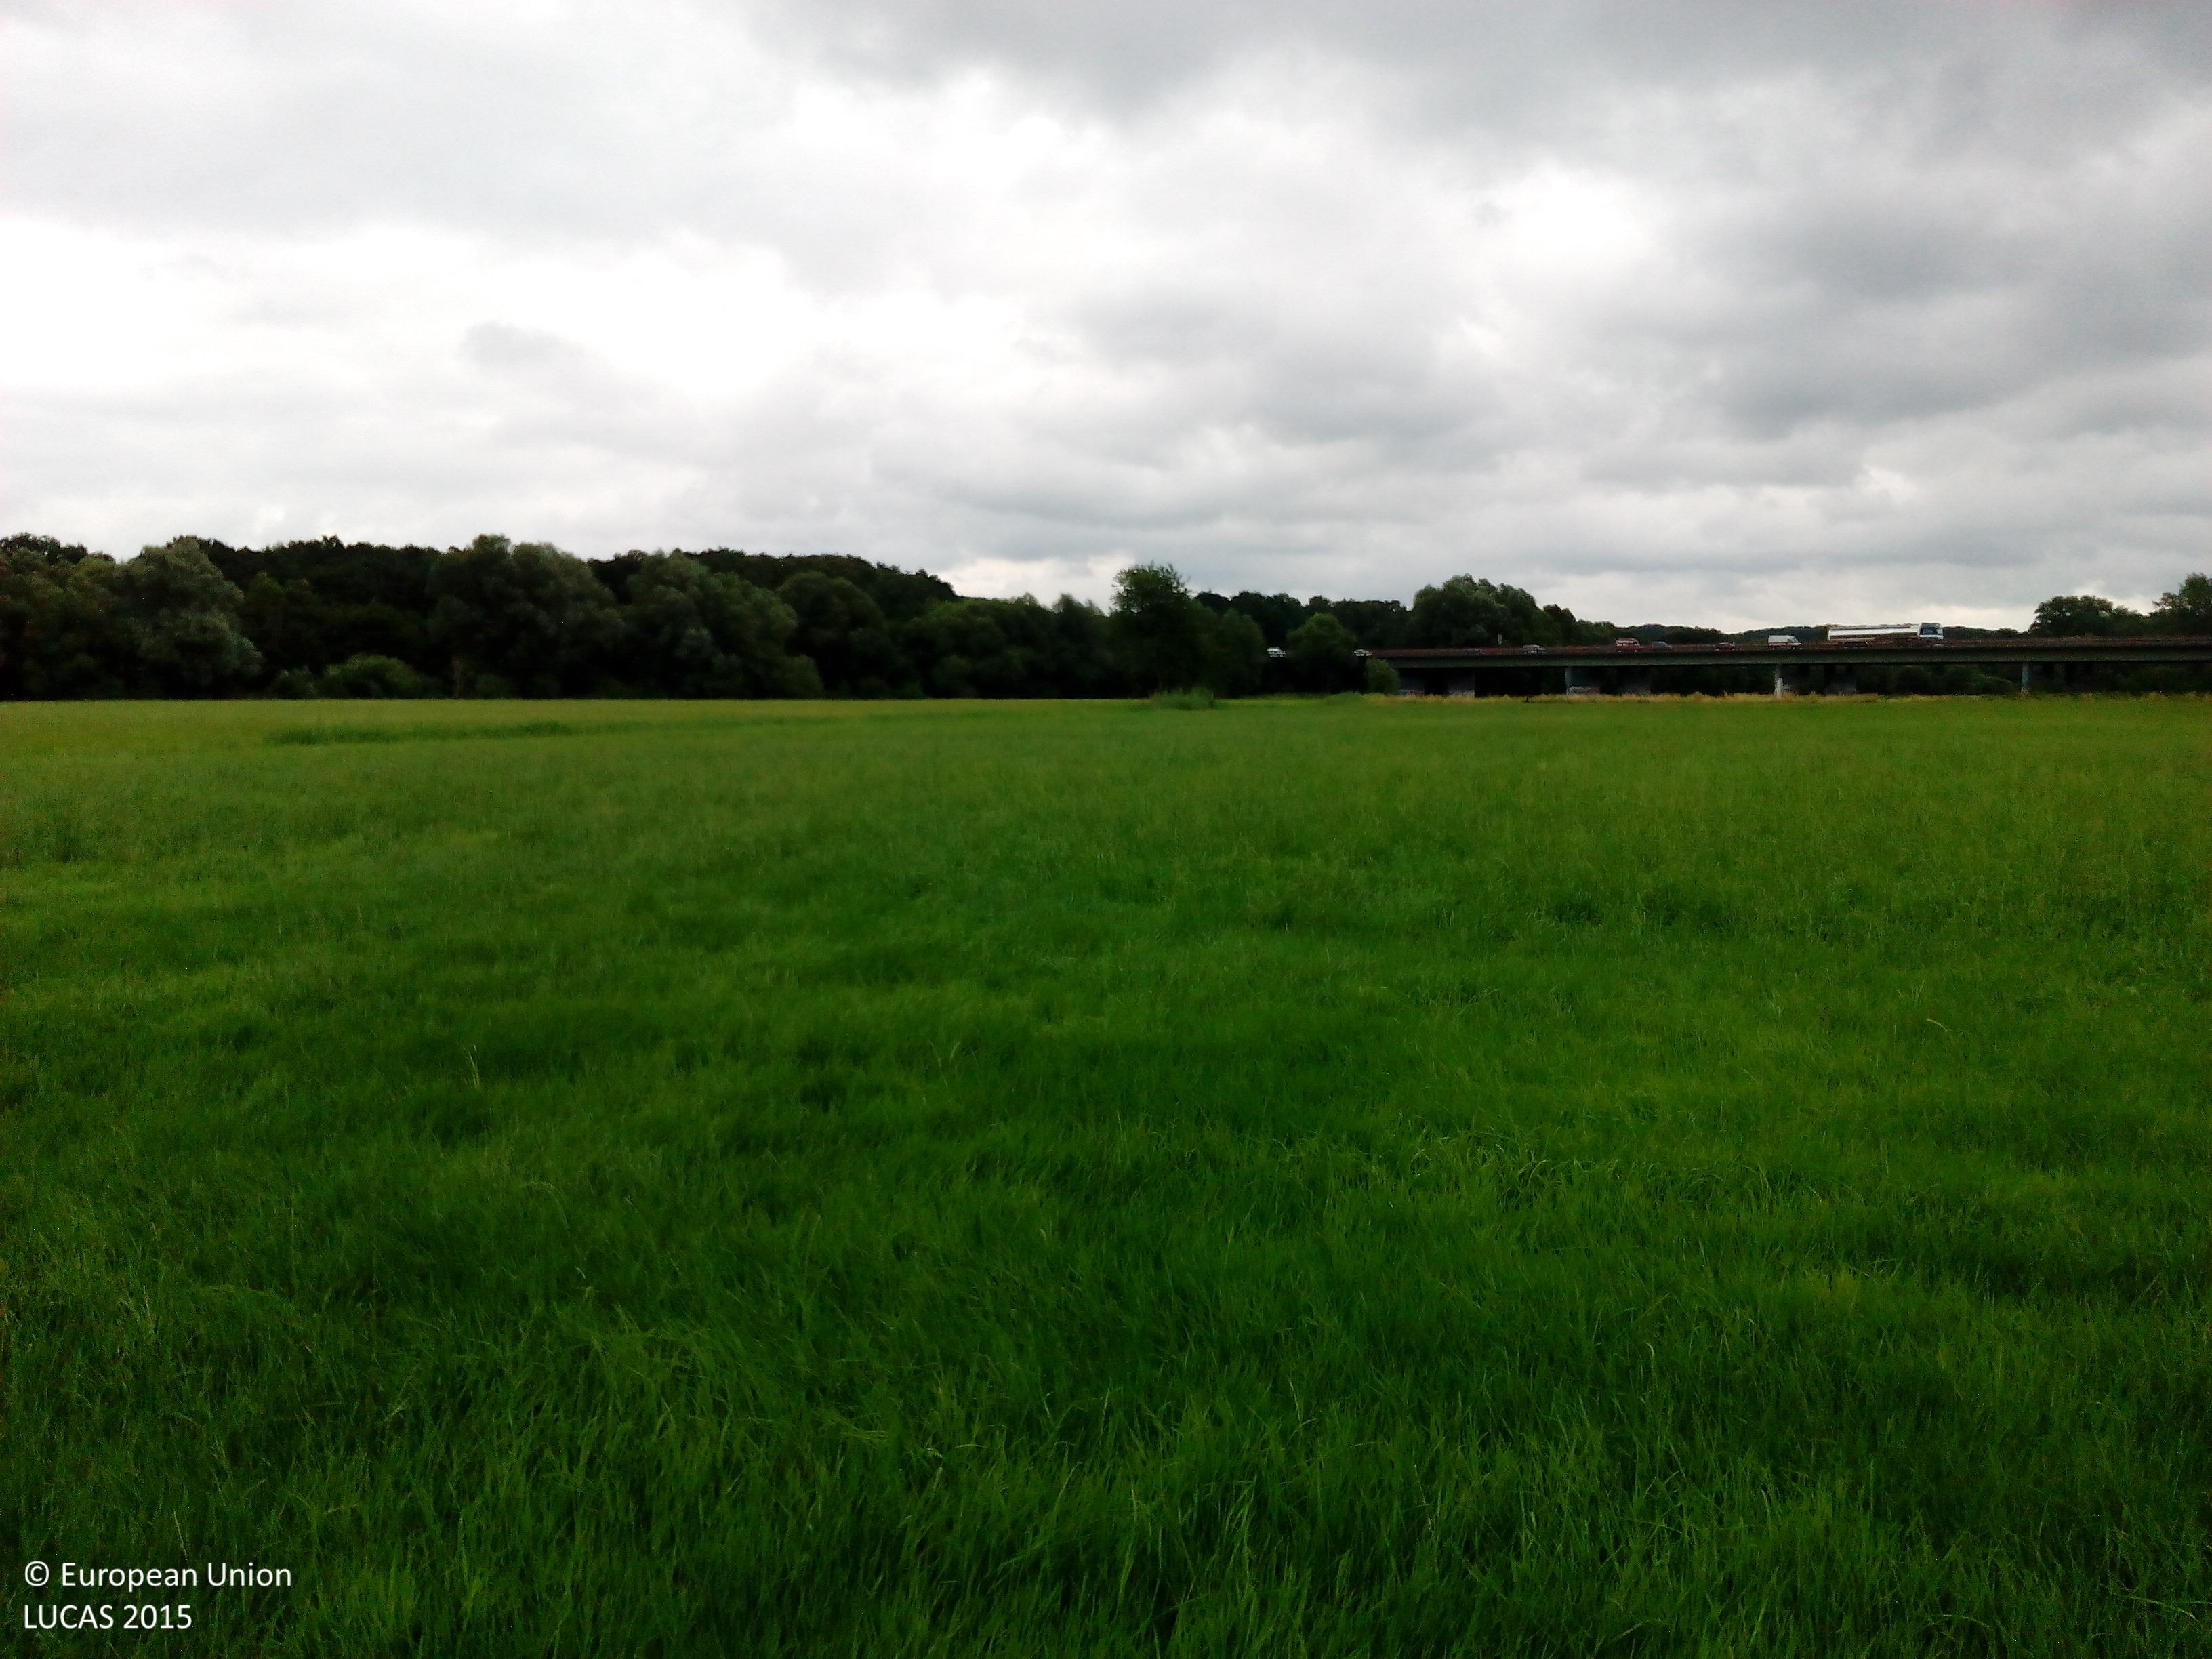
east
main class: Grassland
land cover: Grassland without tree/shrub cover
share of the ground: > 75 %
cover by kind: herbaceous plants 100 %
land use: Agriculture (excluding fallow land and kitchen gardens)
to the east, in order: Grassland without tree/shrub cover; Electric lines; Grassland without tree/shrub cover; Ditches and canals; Grassland without tree/shrub cover
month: July
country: DE
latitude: 52.3240
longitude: 7.9610
